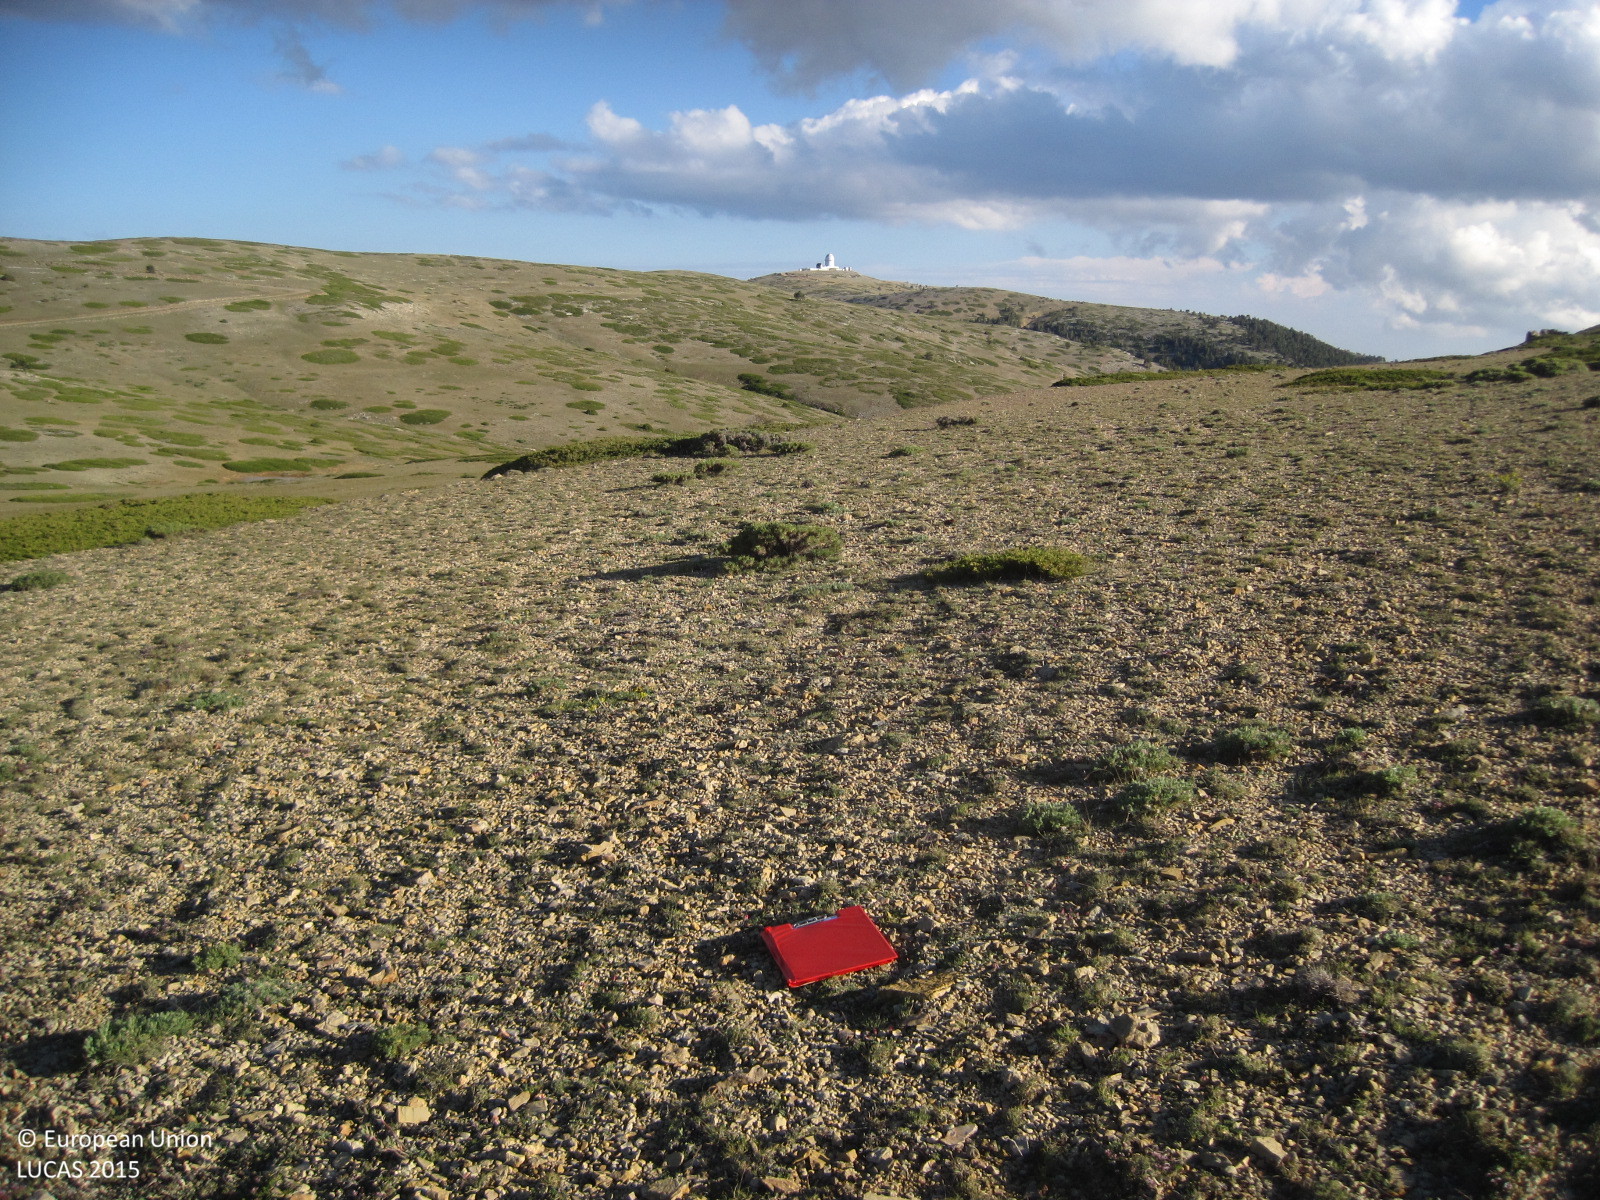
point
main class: Grassland
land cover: Grassland without tree/shrub cover
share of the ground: 50 - 75 %
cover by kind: herbaceous plants 50 %, consolidated bare surface 45 %, shrubs 5 %
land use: Semi-natural and natural areas not in use
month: June
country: ES
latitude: 40.0646
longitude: -1.0162
